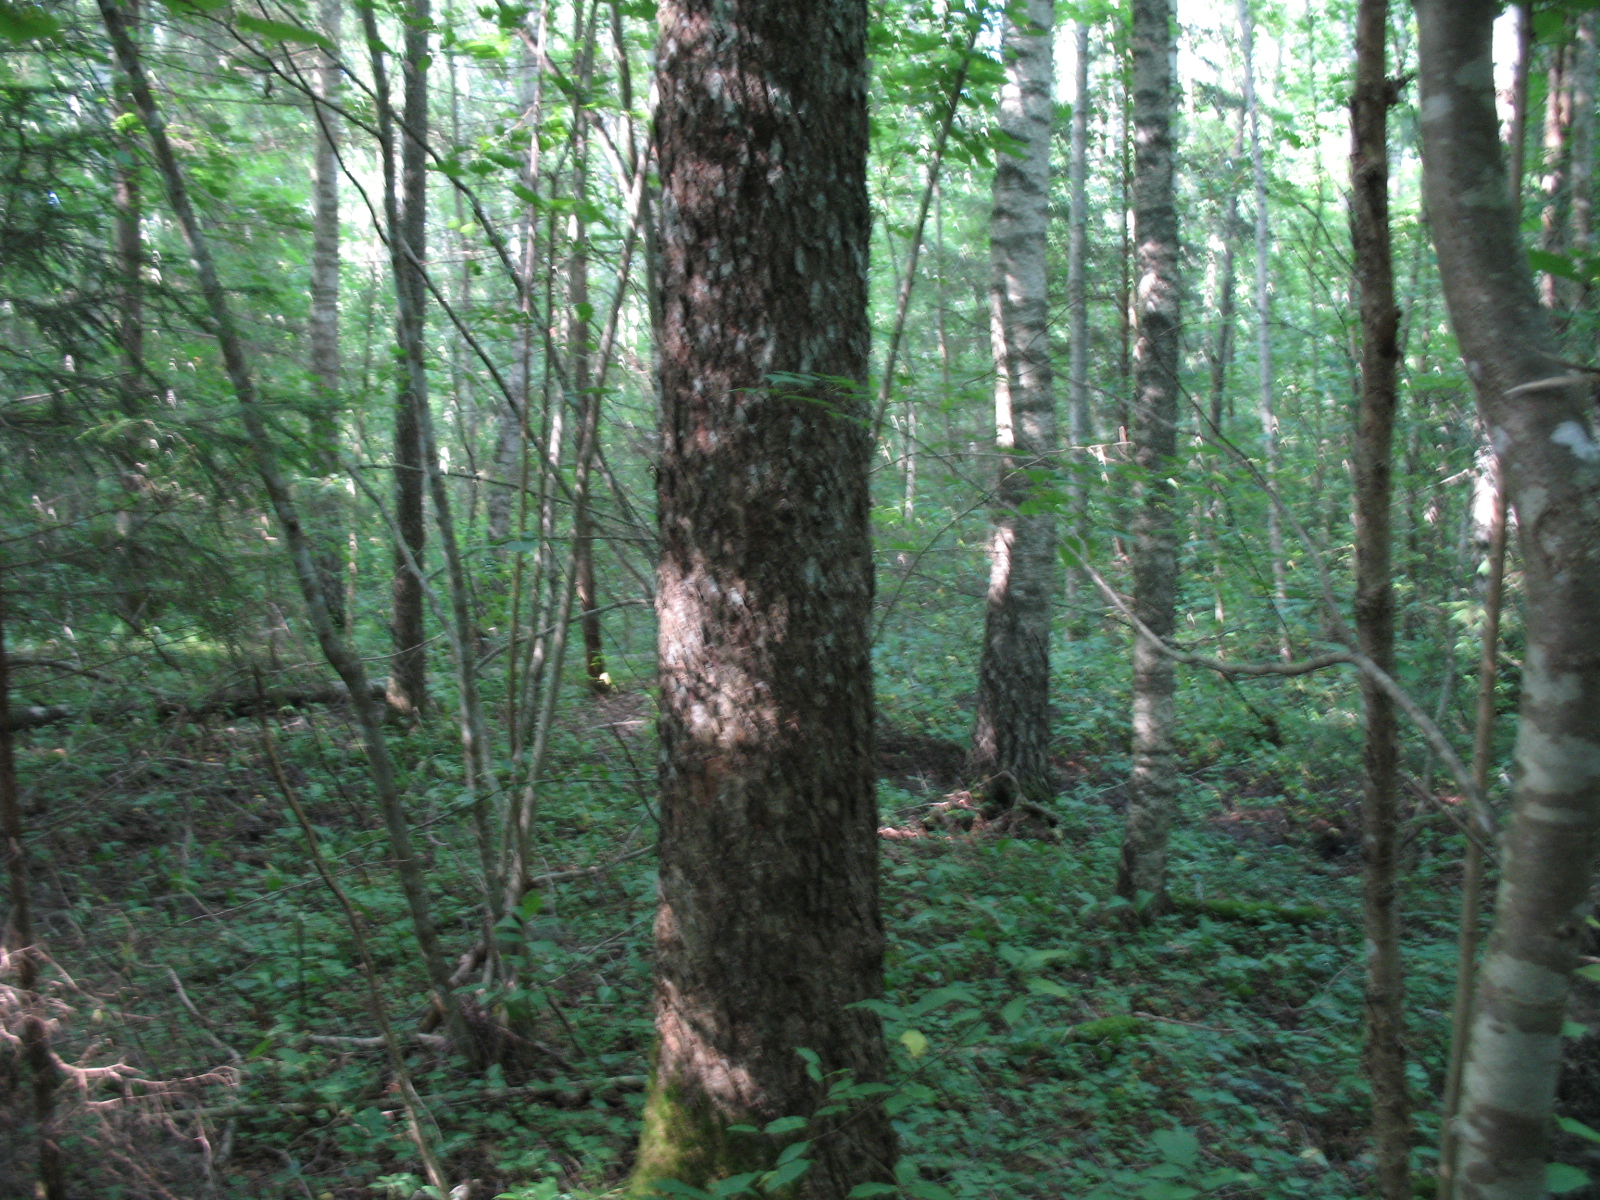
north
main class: Woodland
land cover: Broadleaved woodland
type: non-riverine alder, birch or aspen forest
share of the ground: > 75 %
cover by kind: broadleaved forest trees 85 %, herbaceous plants 10 %, shrubs 5 %
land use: Forestry
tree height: > 5 m
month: July
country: LV
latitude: 56.2574
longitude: 25.1076
